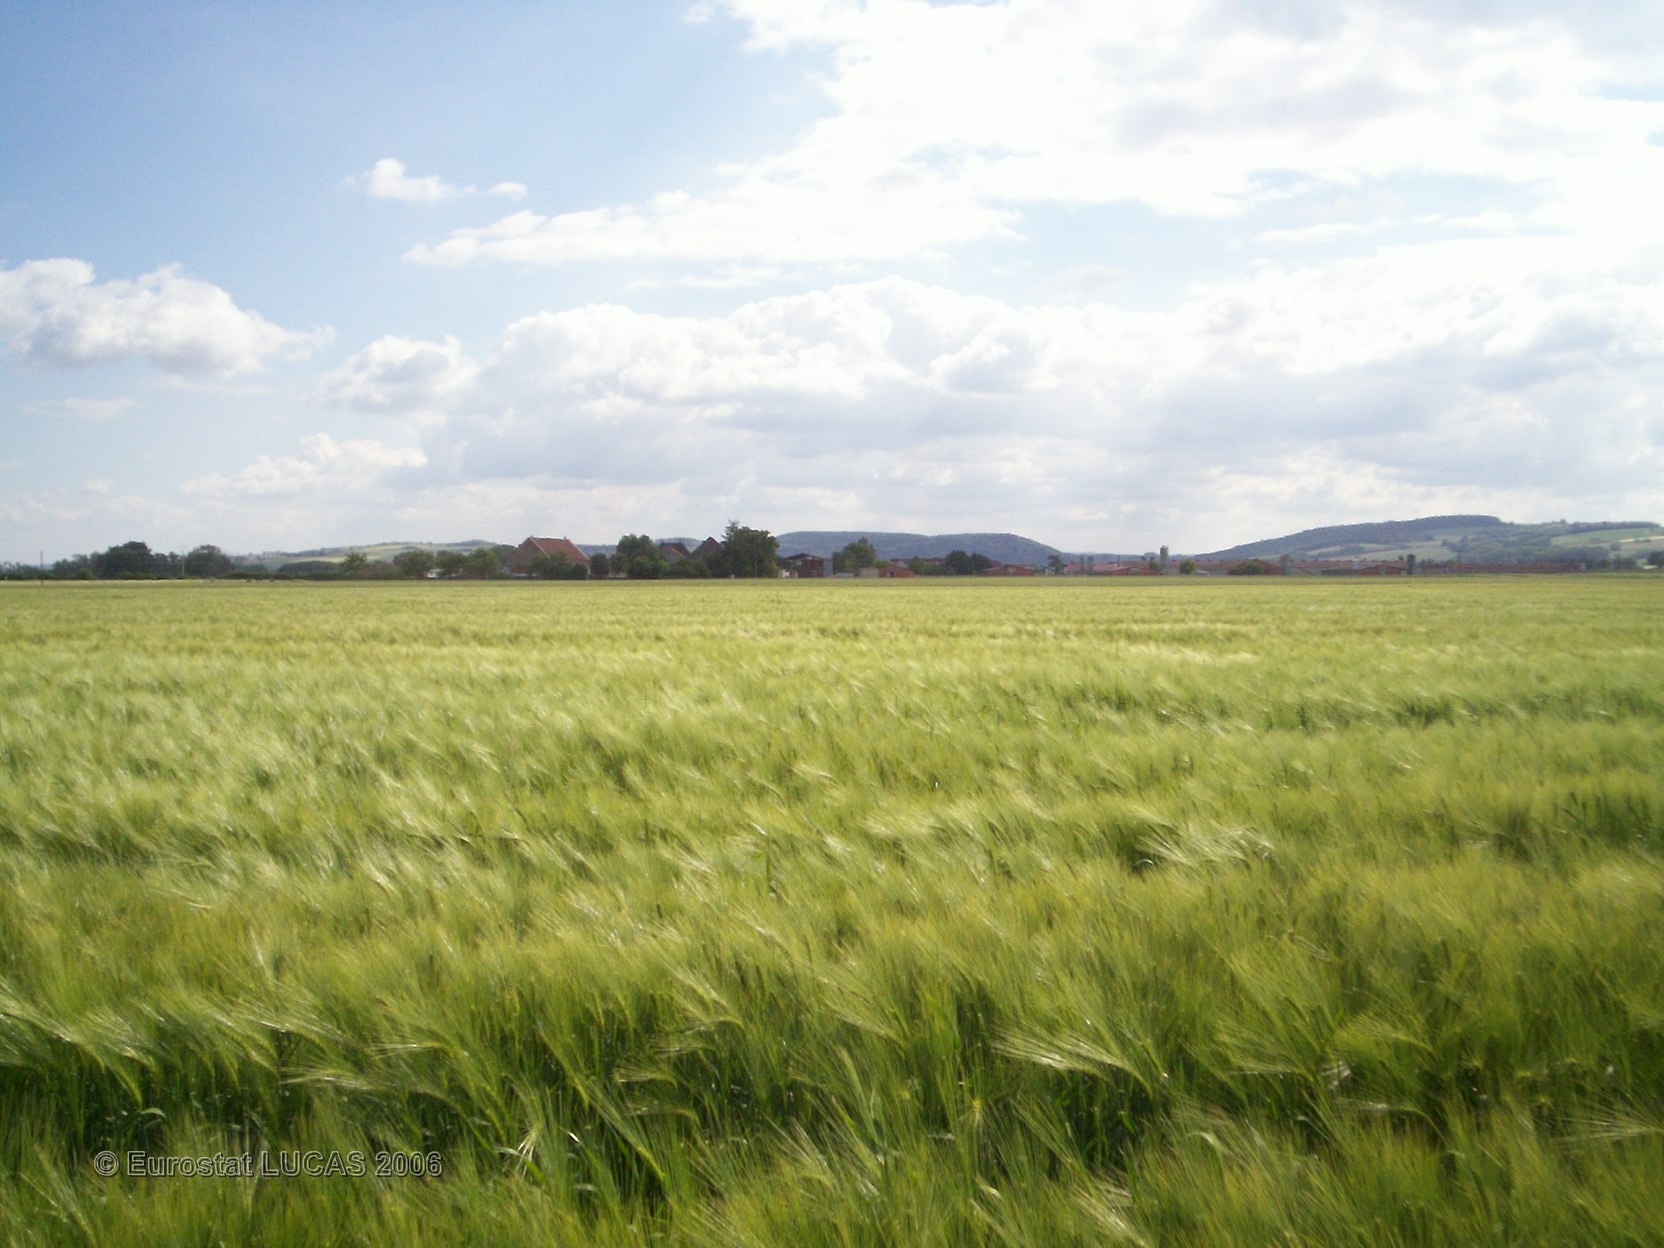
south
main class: Cropland
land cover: Barley
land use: Agriculture (excluding fallow land and kitchen gardens)
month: June
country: FR
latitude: 46.1904
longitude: 3.2224
